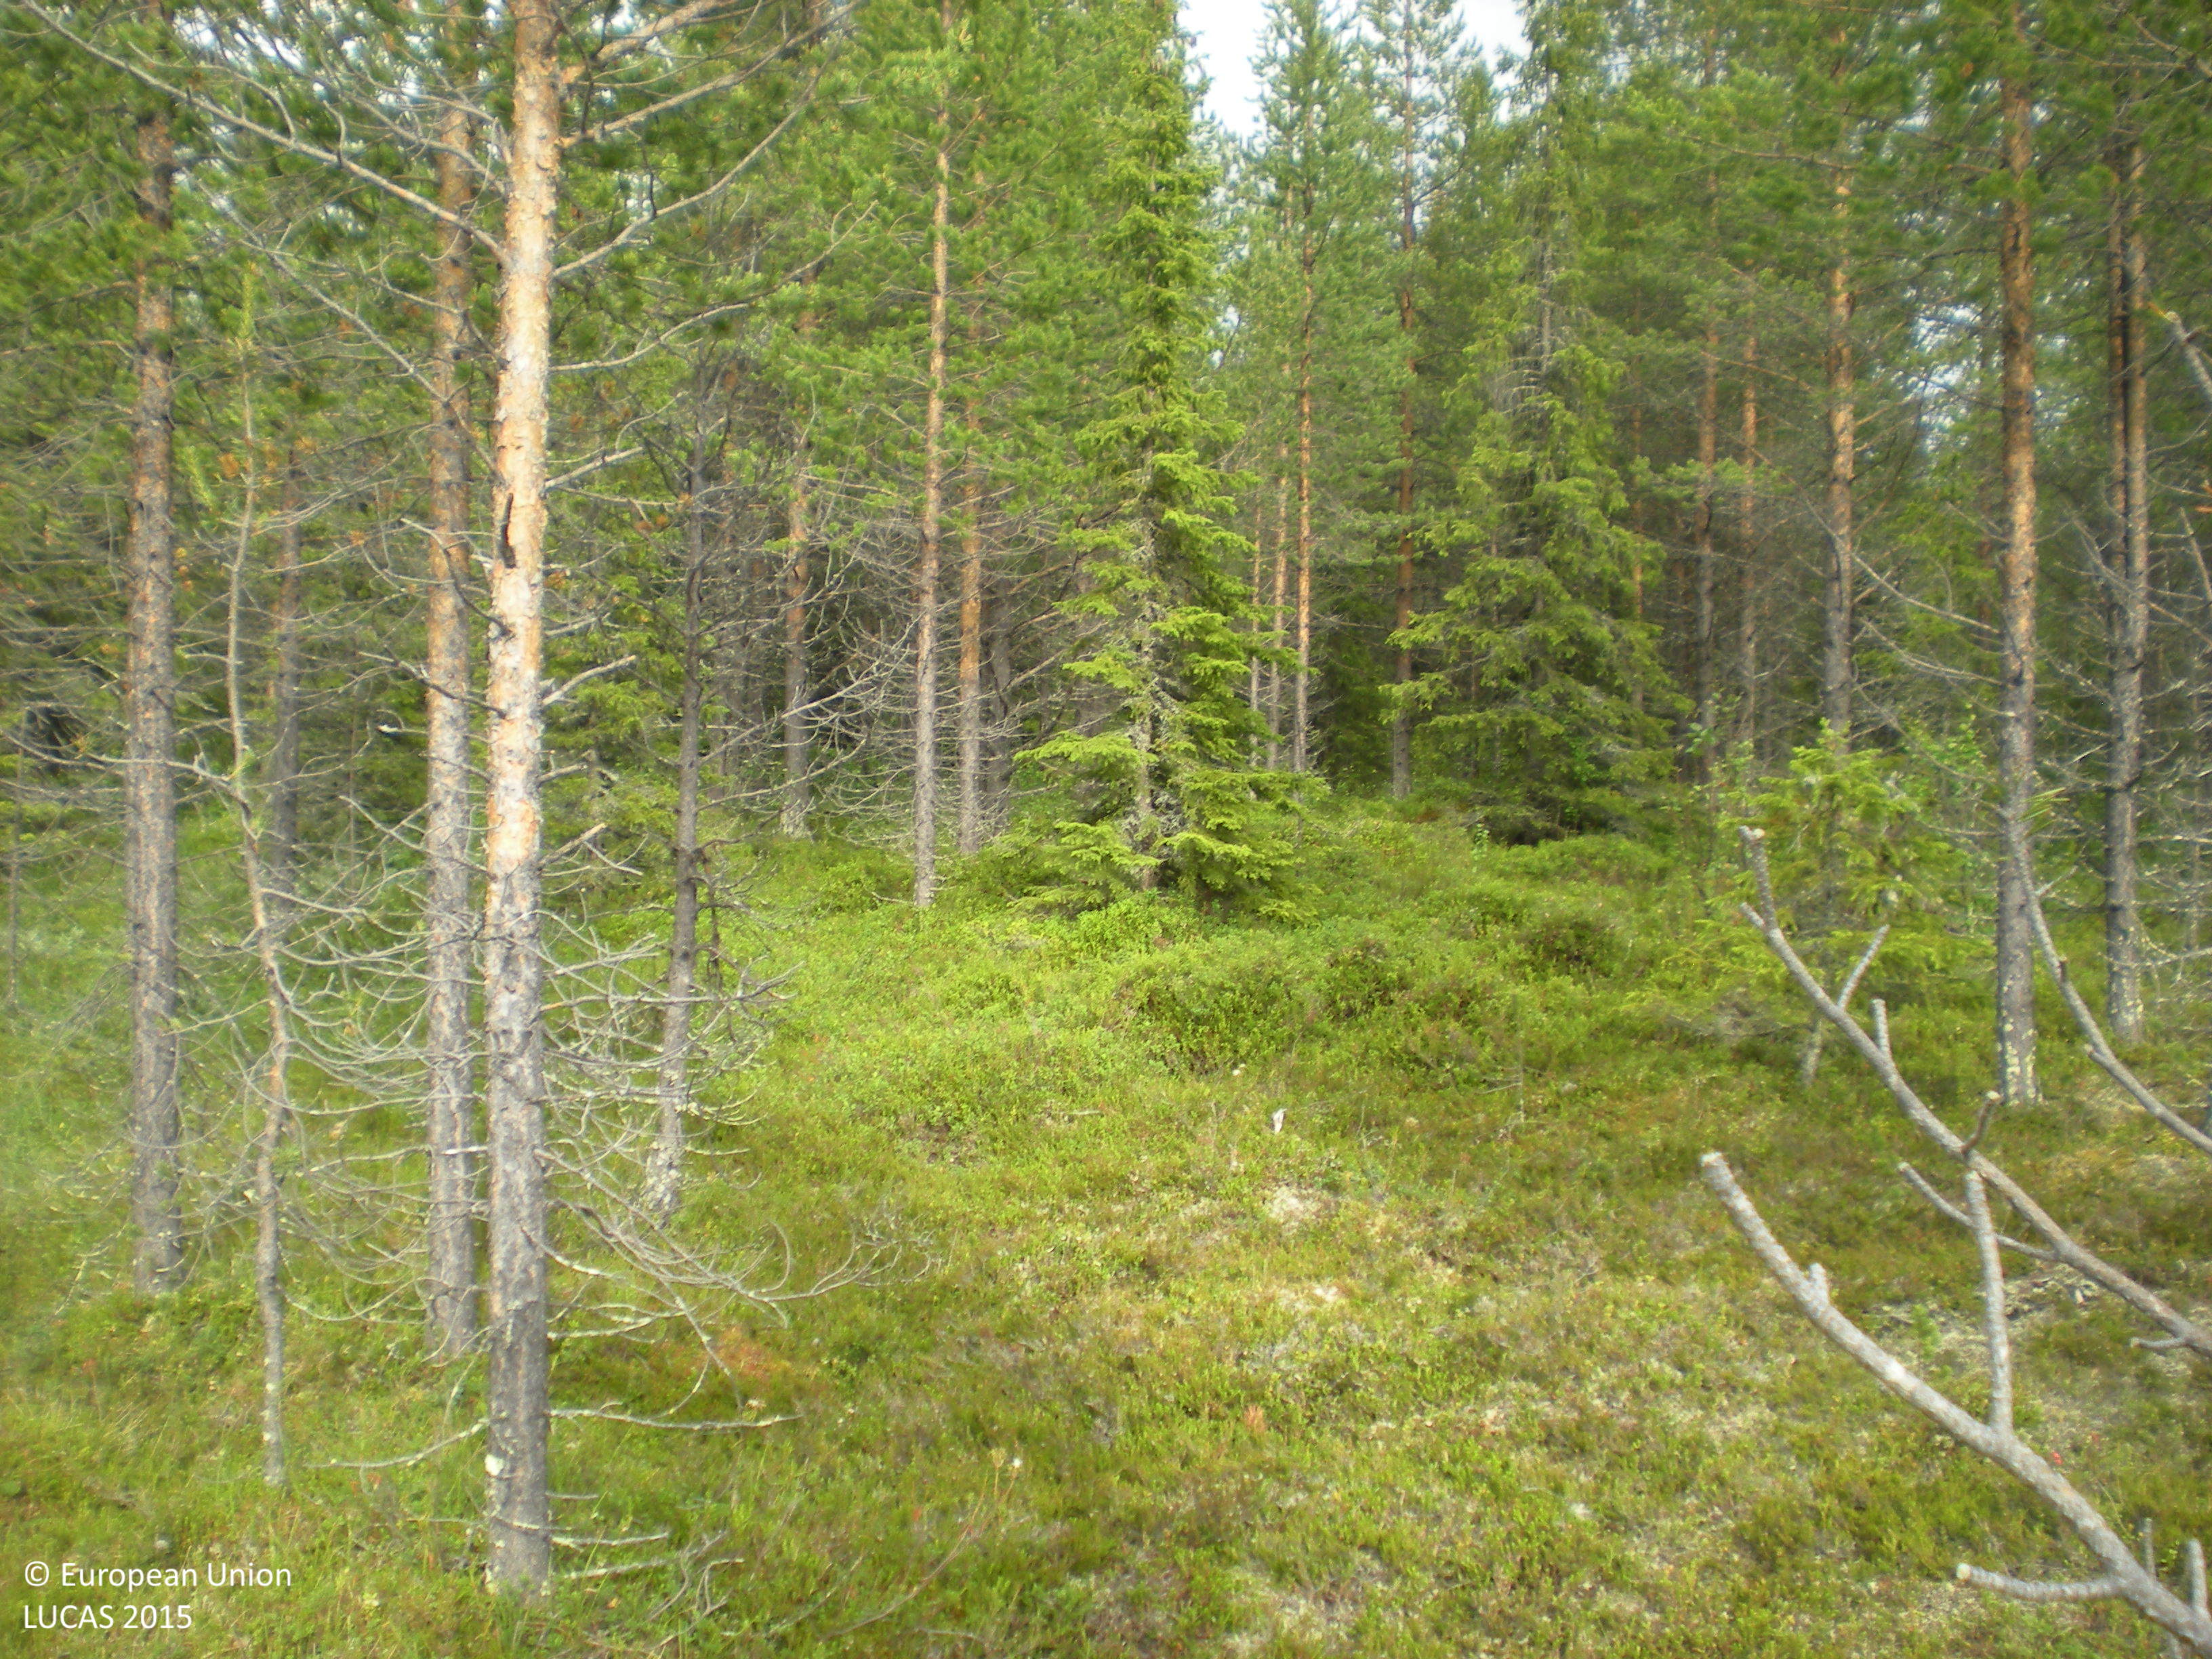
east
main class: Woodland
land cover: Pine dominated coniferous woodland
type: mire and swamp forests
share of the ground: 25 - 50 %
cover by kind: shrubs 45 %, coniferous forest trees 30 %, herbaceous plants 15 %, lichens and mosses 10 %
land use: Forestry
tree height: < 5 m
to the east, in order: Pine dominated coniferous woodland; Other coniferous woodland; Other mixed woodland; Pine dominated mixed woodland; Inland fresh water bodies; Peatbogs; Broadleaved woodland; Pine dominated coniferous woodland
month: July
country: SE
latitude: 65.9403
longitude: 18.0234
